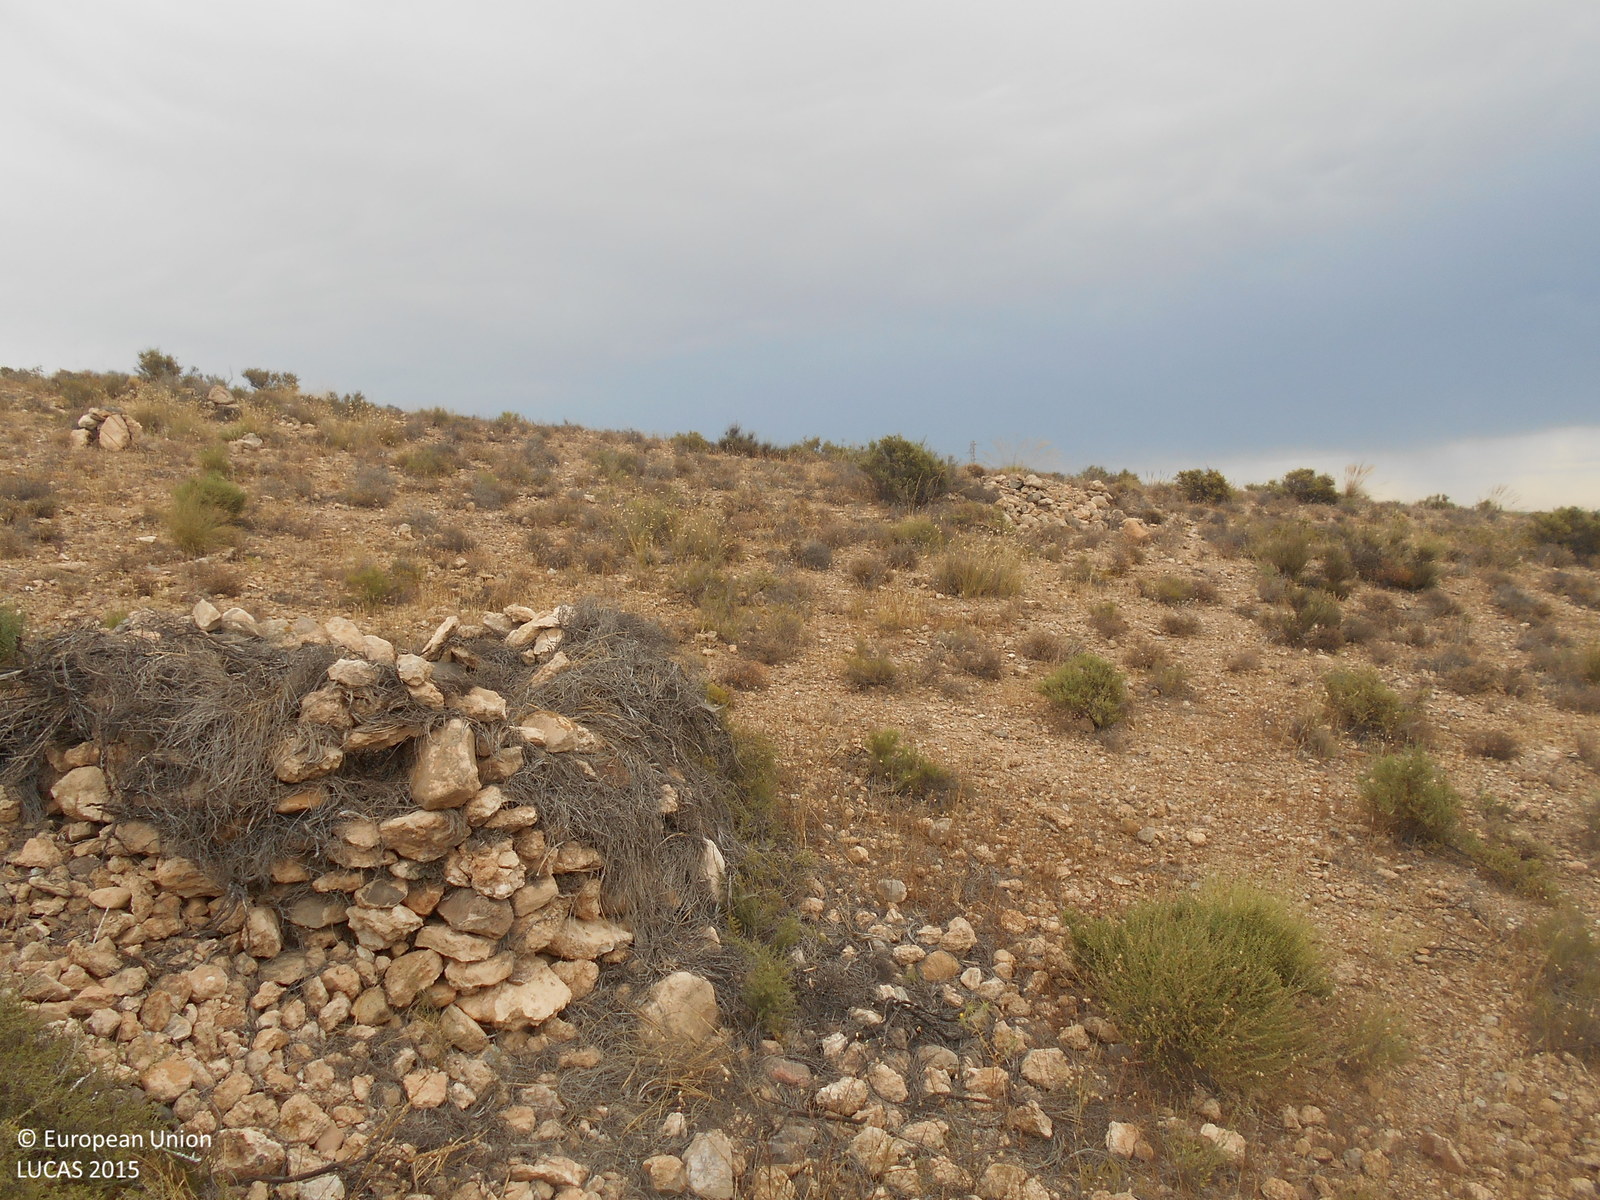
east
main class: Shrubland
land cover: Shrubland without tree cover
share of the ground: 10 - 25 %
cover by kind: unconsolidated bare surface 40 %, herbaceous plants 30 %, shrubs 20 %, consolidated bare surface 10 %
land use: Semi-natural and natural areas not in use
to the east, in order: Shrubland without tree cover; Tracks; Fences; Artificial constructions in urban areas; Grassland with sparse tree/shrub cover; Tracks; Grassland without tree/shrub cover; Artificial constructions in urban areas; Artificial constructions; Shruby margins; Fences; Spontaneously vegetated surfaces; Tracks; Shrubland without tree cover; Electric lines; Shrubland without tree cover; Tracks; Shrubland without tree cover; Artificial constructions in urban areas
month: May
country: ES
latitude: 36.8928
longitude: -2.2846
